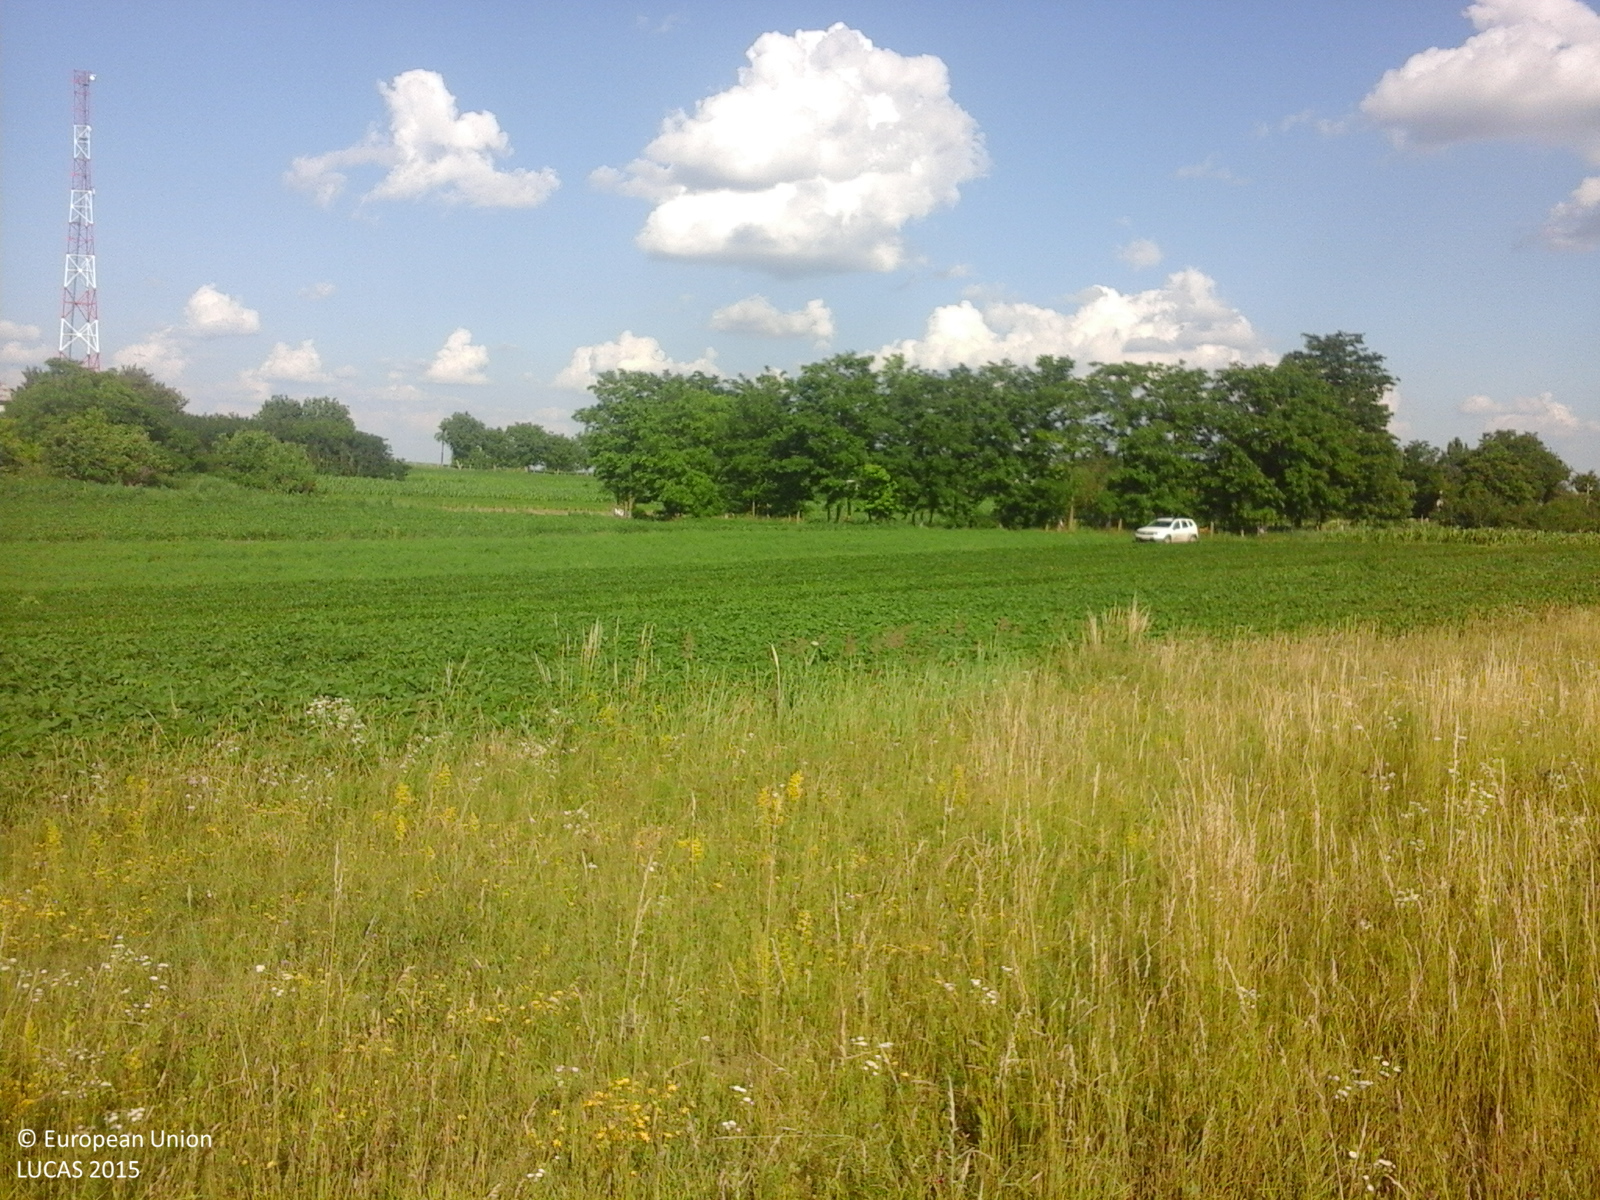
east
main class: Grassland
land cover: Grassland without tree/shrub cover
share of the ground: > 75 %
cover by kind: herbaceous plants 100 %
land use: Agriculture (excluding fallow land and kitchen gardens)
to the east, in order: Grassland without tree/shrub cover; Soya; Lucerne; Soya; Grass margins; Tracks; Soya; Maize; Oats; Maize; Other bare soil; Soya; Maize
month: June
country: RO
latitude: 48.2418
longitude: 26.7021
